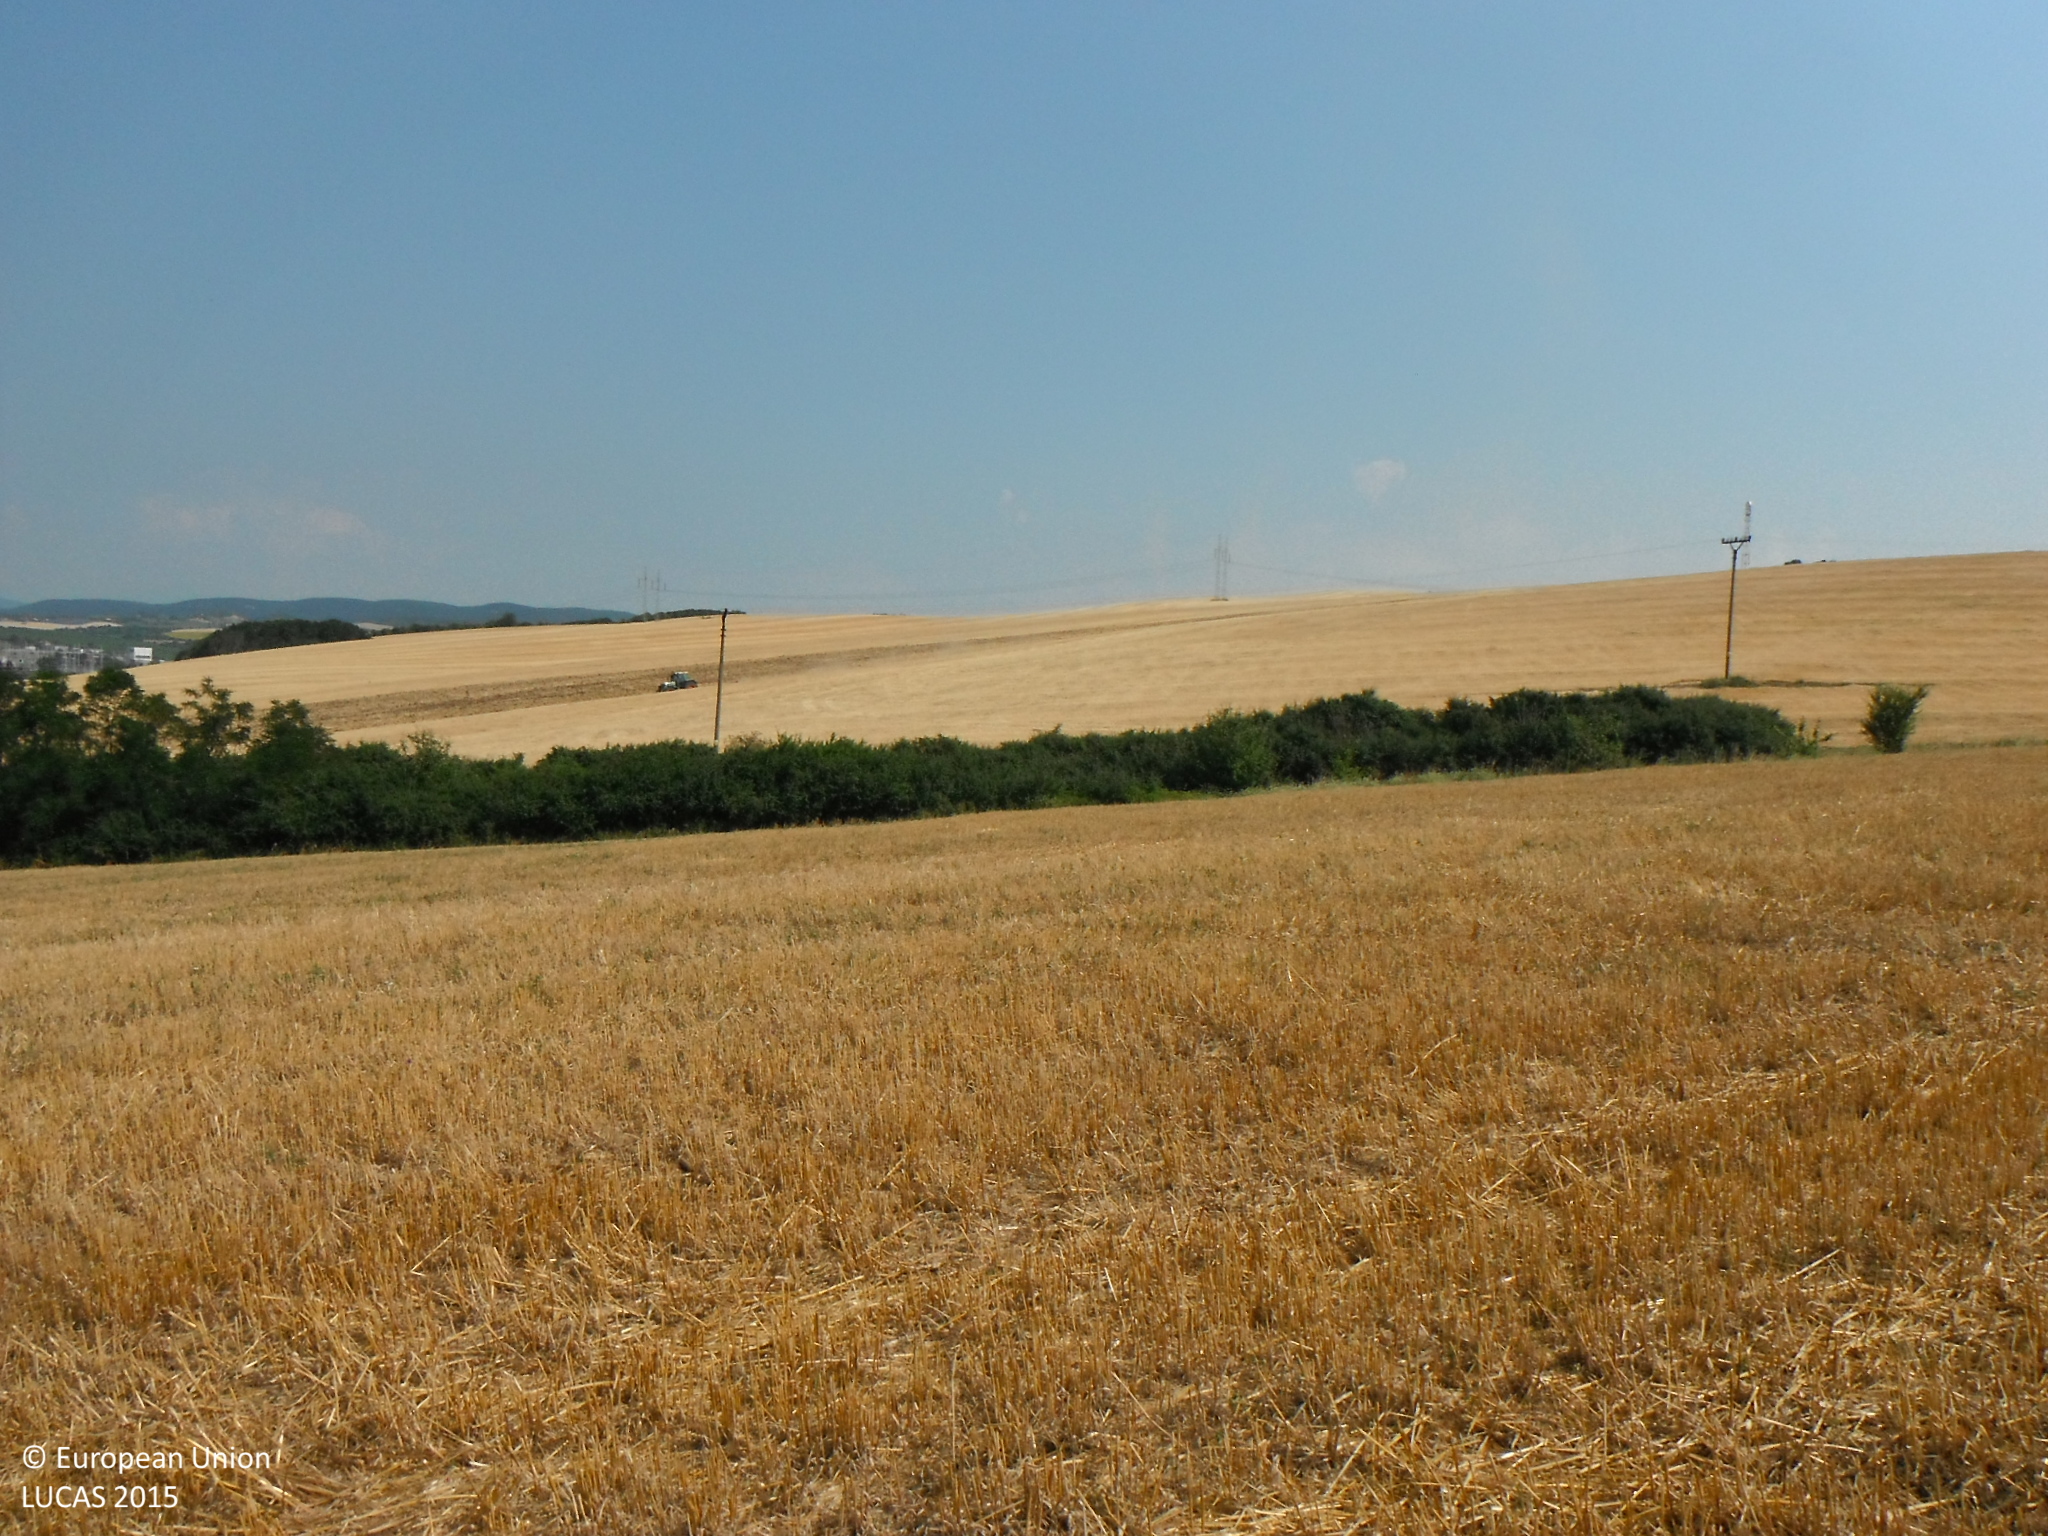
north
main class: Cropland
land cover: Barley
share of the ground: > 75 %
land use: Agriculture (excluding fallow land and kitchen gardens)
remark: Harvested field
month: July
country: SK
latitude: 48.3608
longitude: 20.0578
